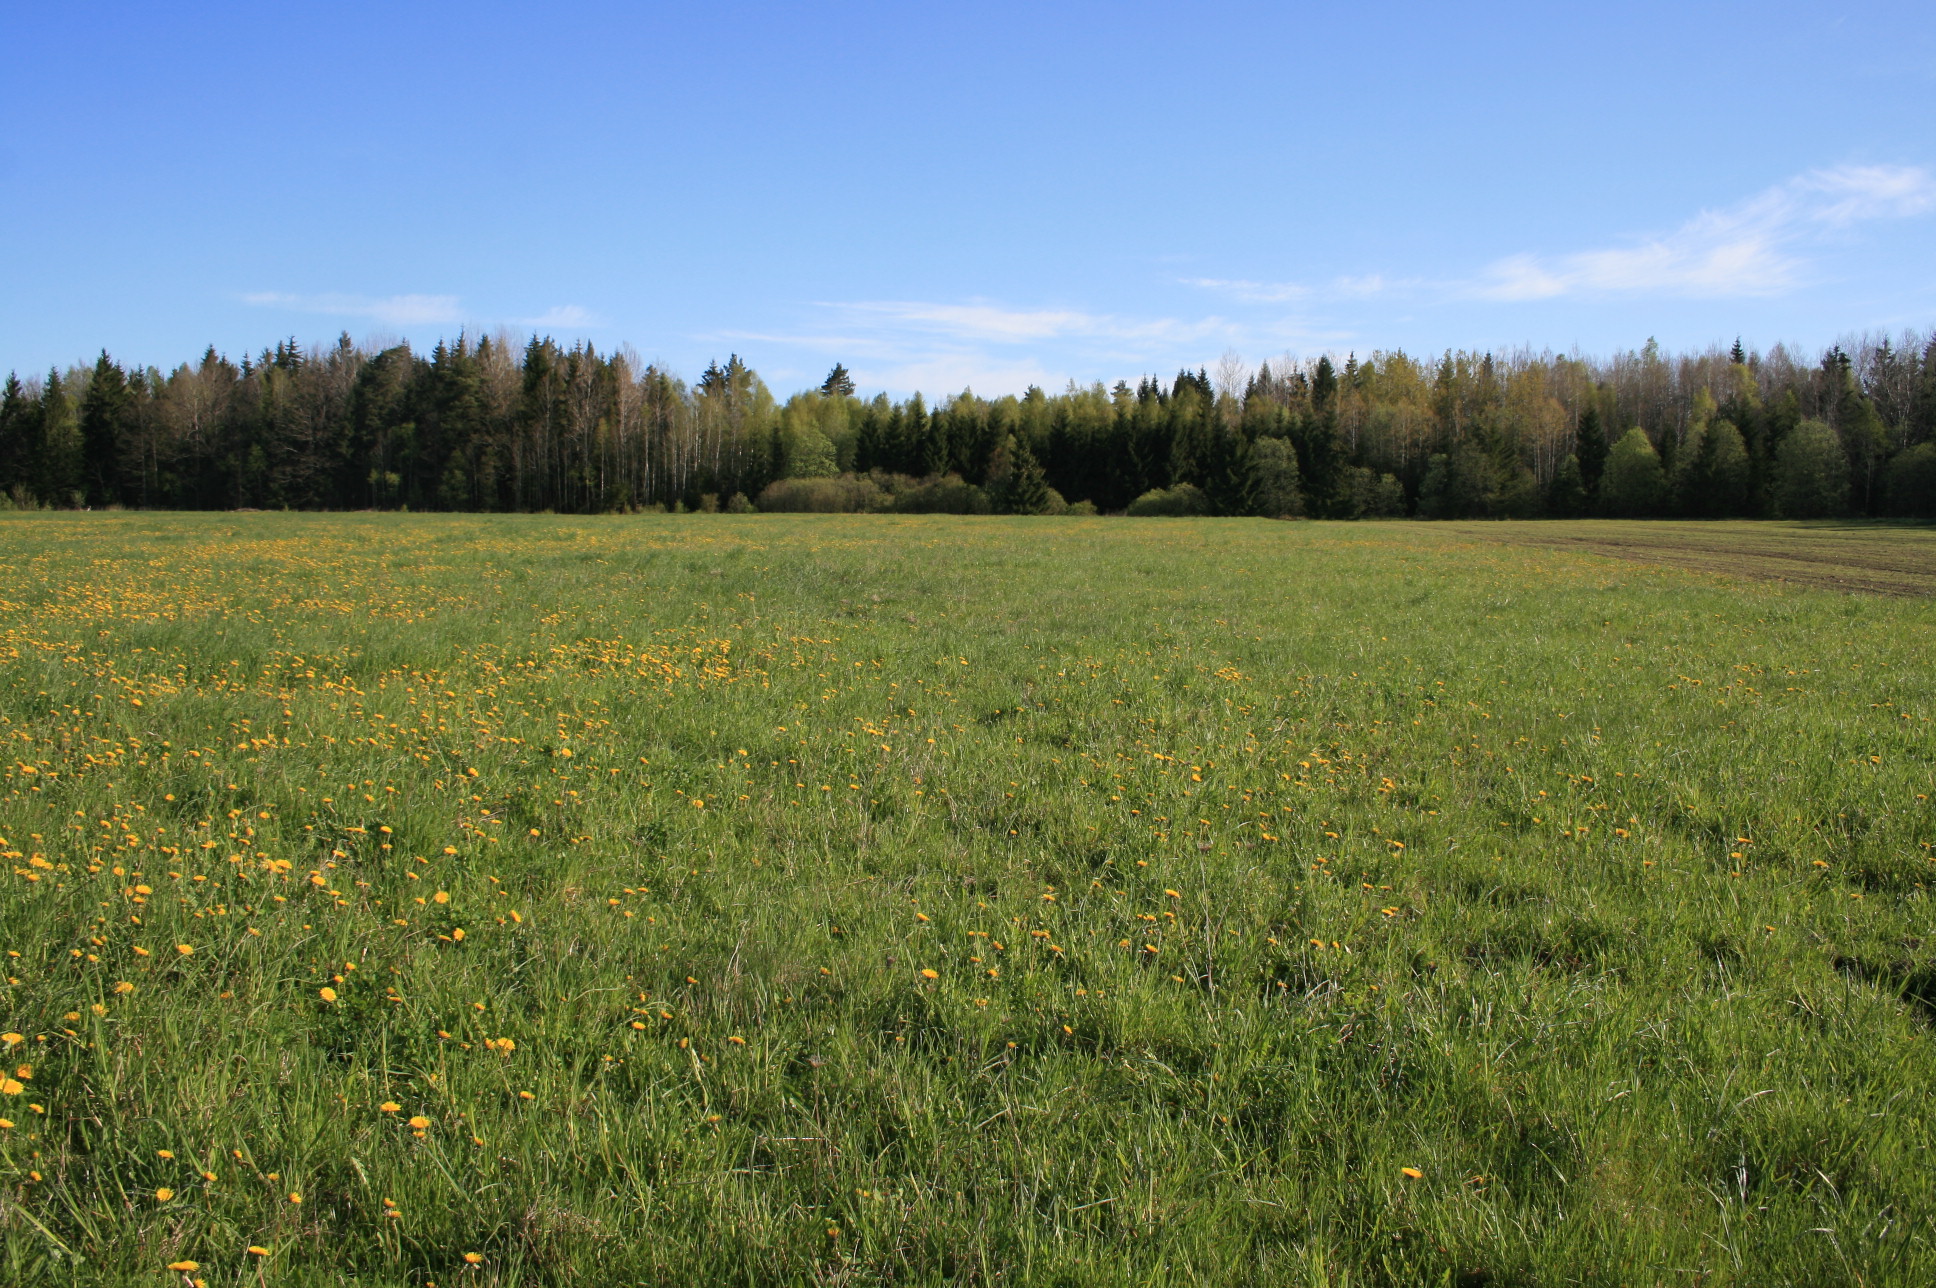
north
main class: Grassland
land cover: Grassland without tree/shrub cover
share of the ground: > 75 %
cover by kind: herbaceous plants 95 %, lichens and mosses 5 %
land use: Agriculture (excluding fallow land and kitchen gardens)
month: May
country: LT
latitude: 56.1045
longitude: 21.5076
